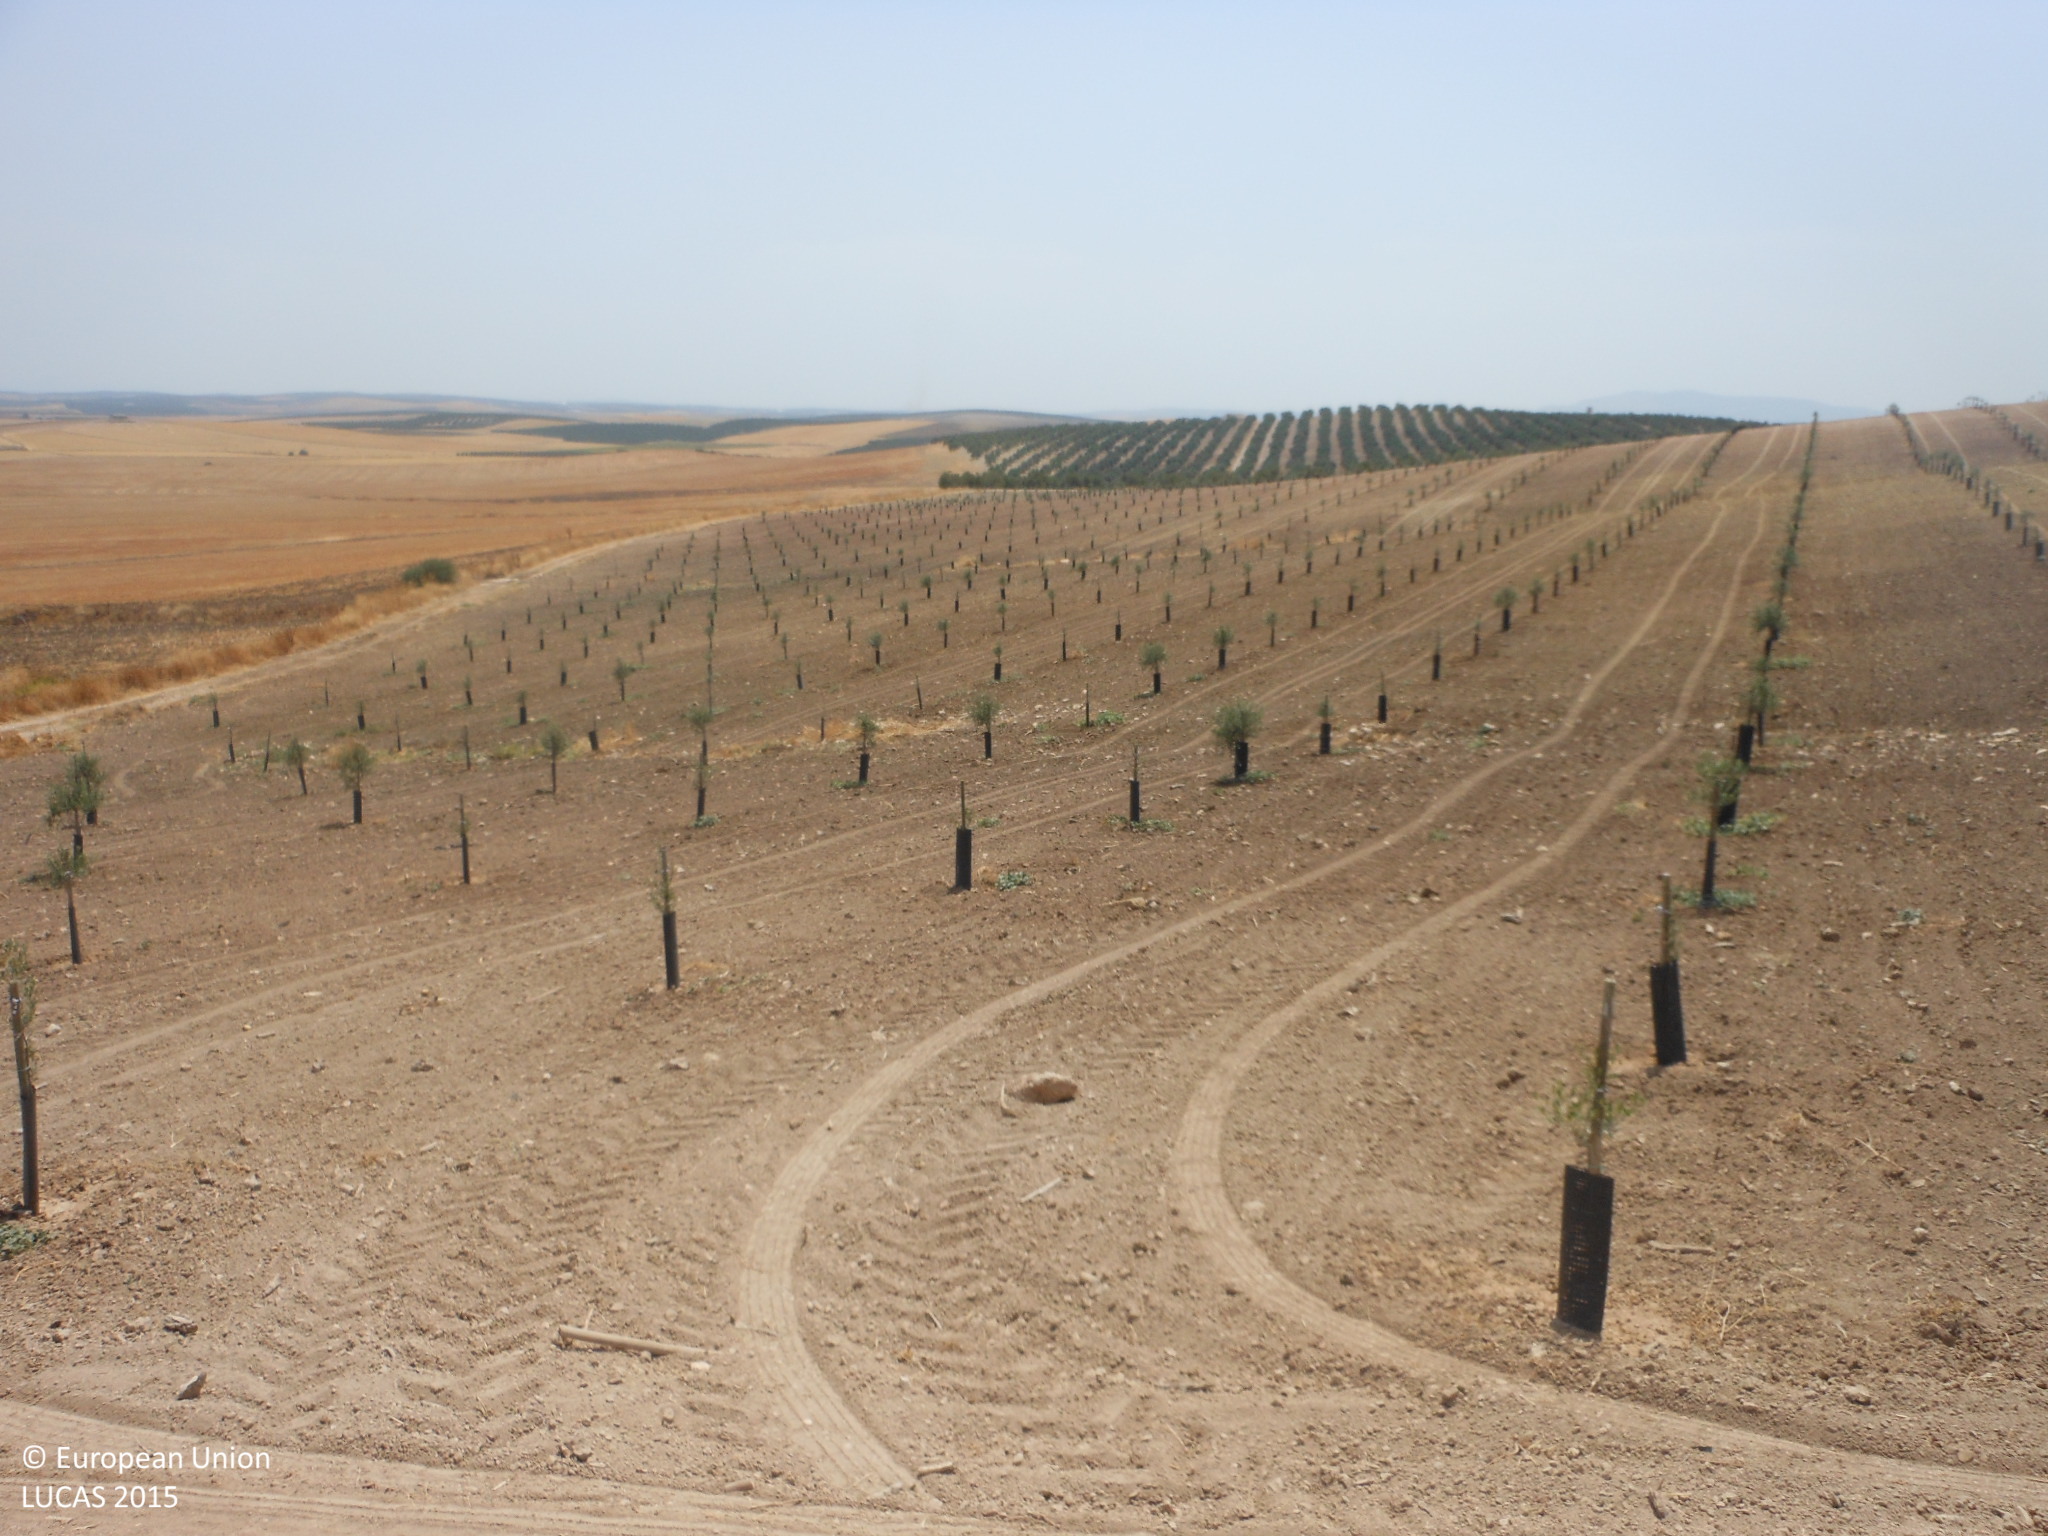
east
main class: Cropland
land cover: Olive groves
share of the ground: 25 - 50 %
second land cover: Other bare soil
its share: > 75 %
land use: Agriculture (excluding fallow land and kitchen gardens)
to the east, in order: Grass margins; Olive groves; Other bare soil; Tracks; Olive groves; Tracks; Grass margins; Dry pulses
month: July
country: ES
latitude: 37.3866
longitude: -5.0652
